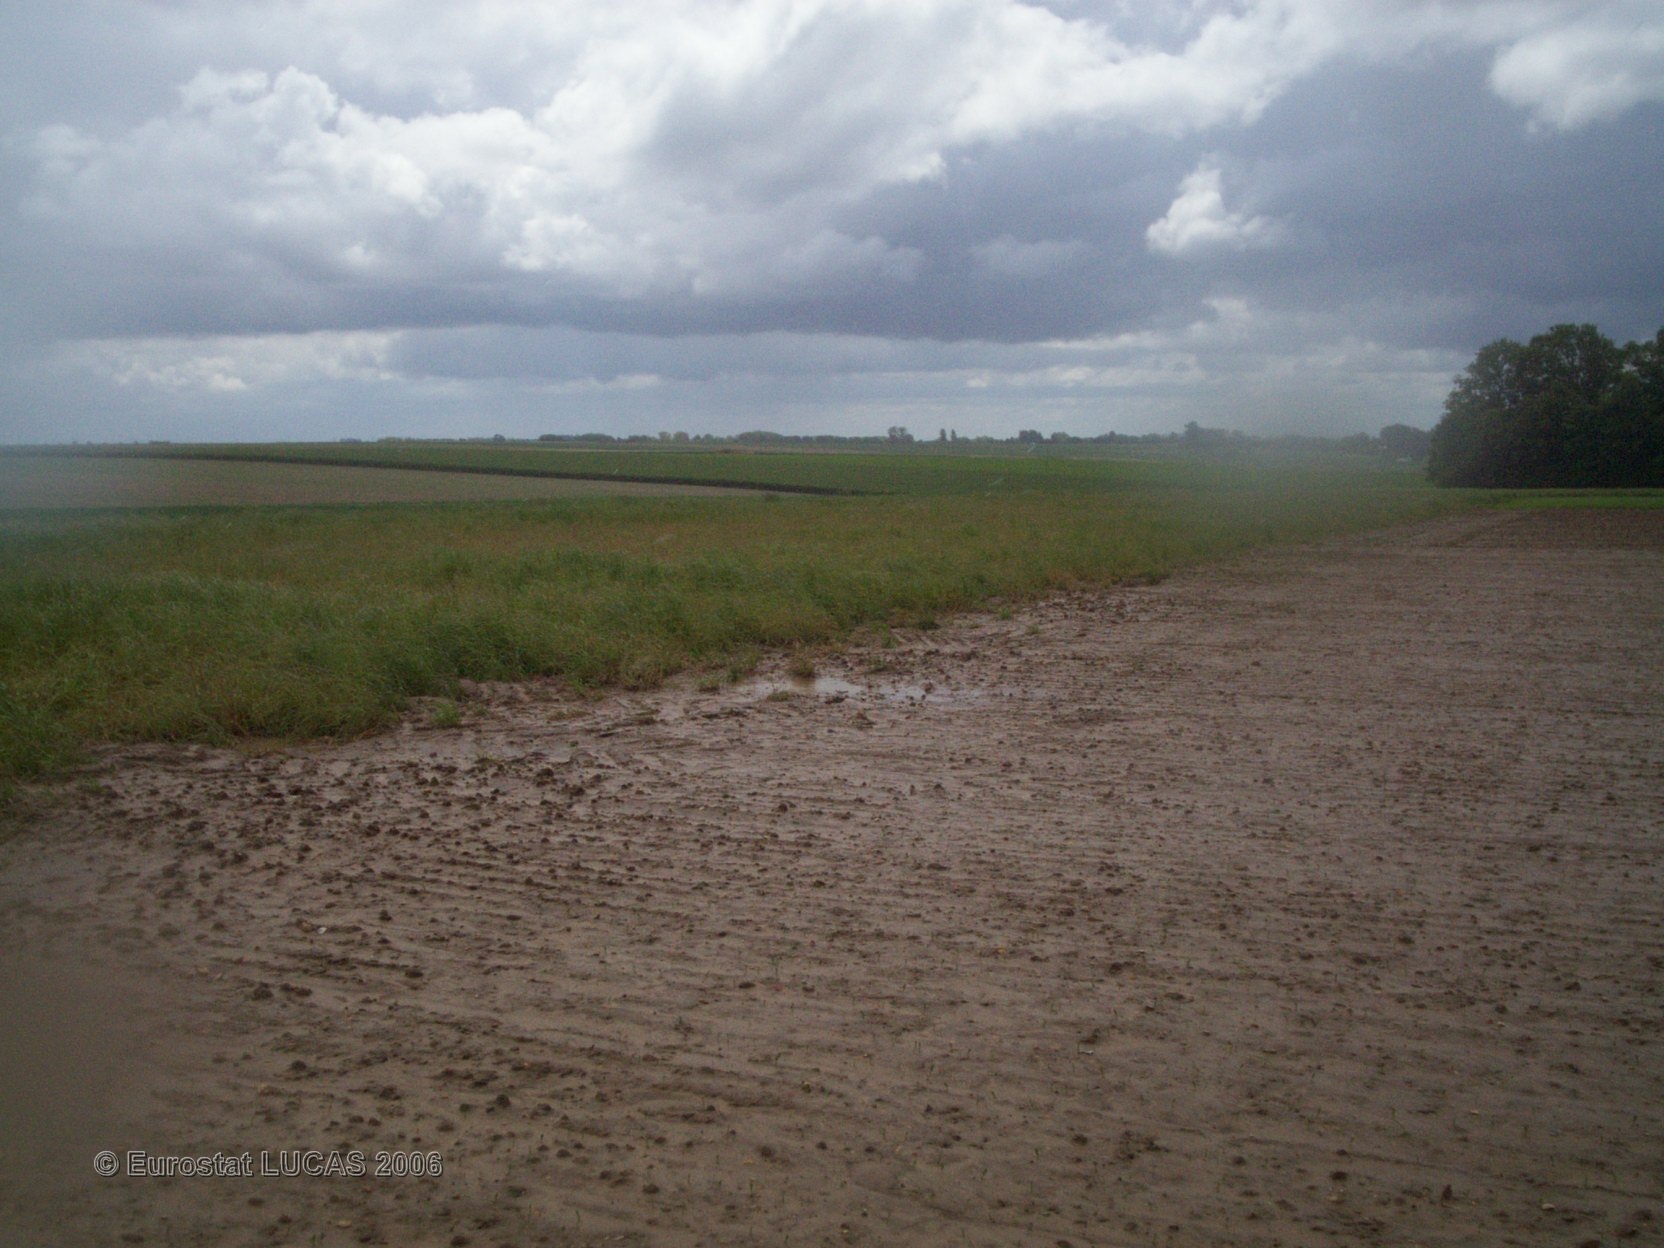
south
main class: Cropland
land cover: Dry pulses
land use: Agriculture (excluding fallow land and kitchen gardens)
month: May
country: FR
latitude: 50.1771
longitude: 2.5805
